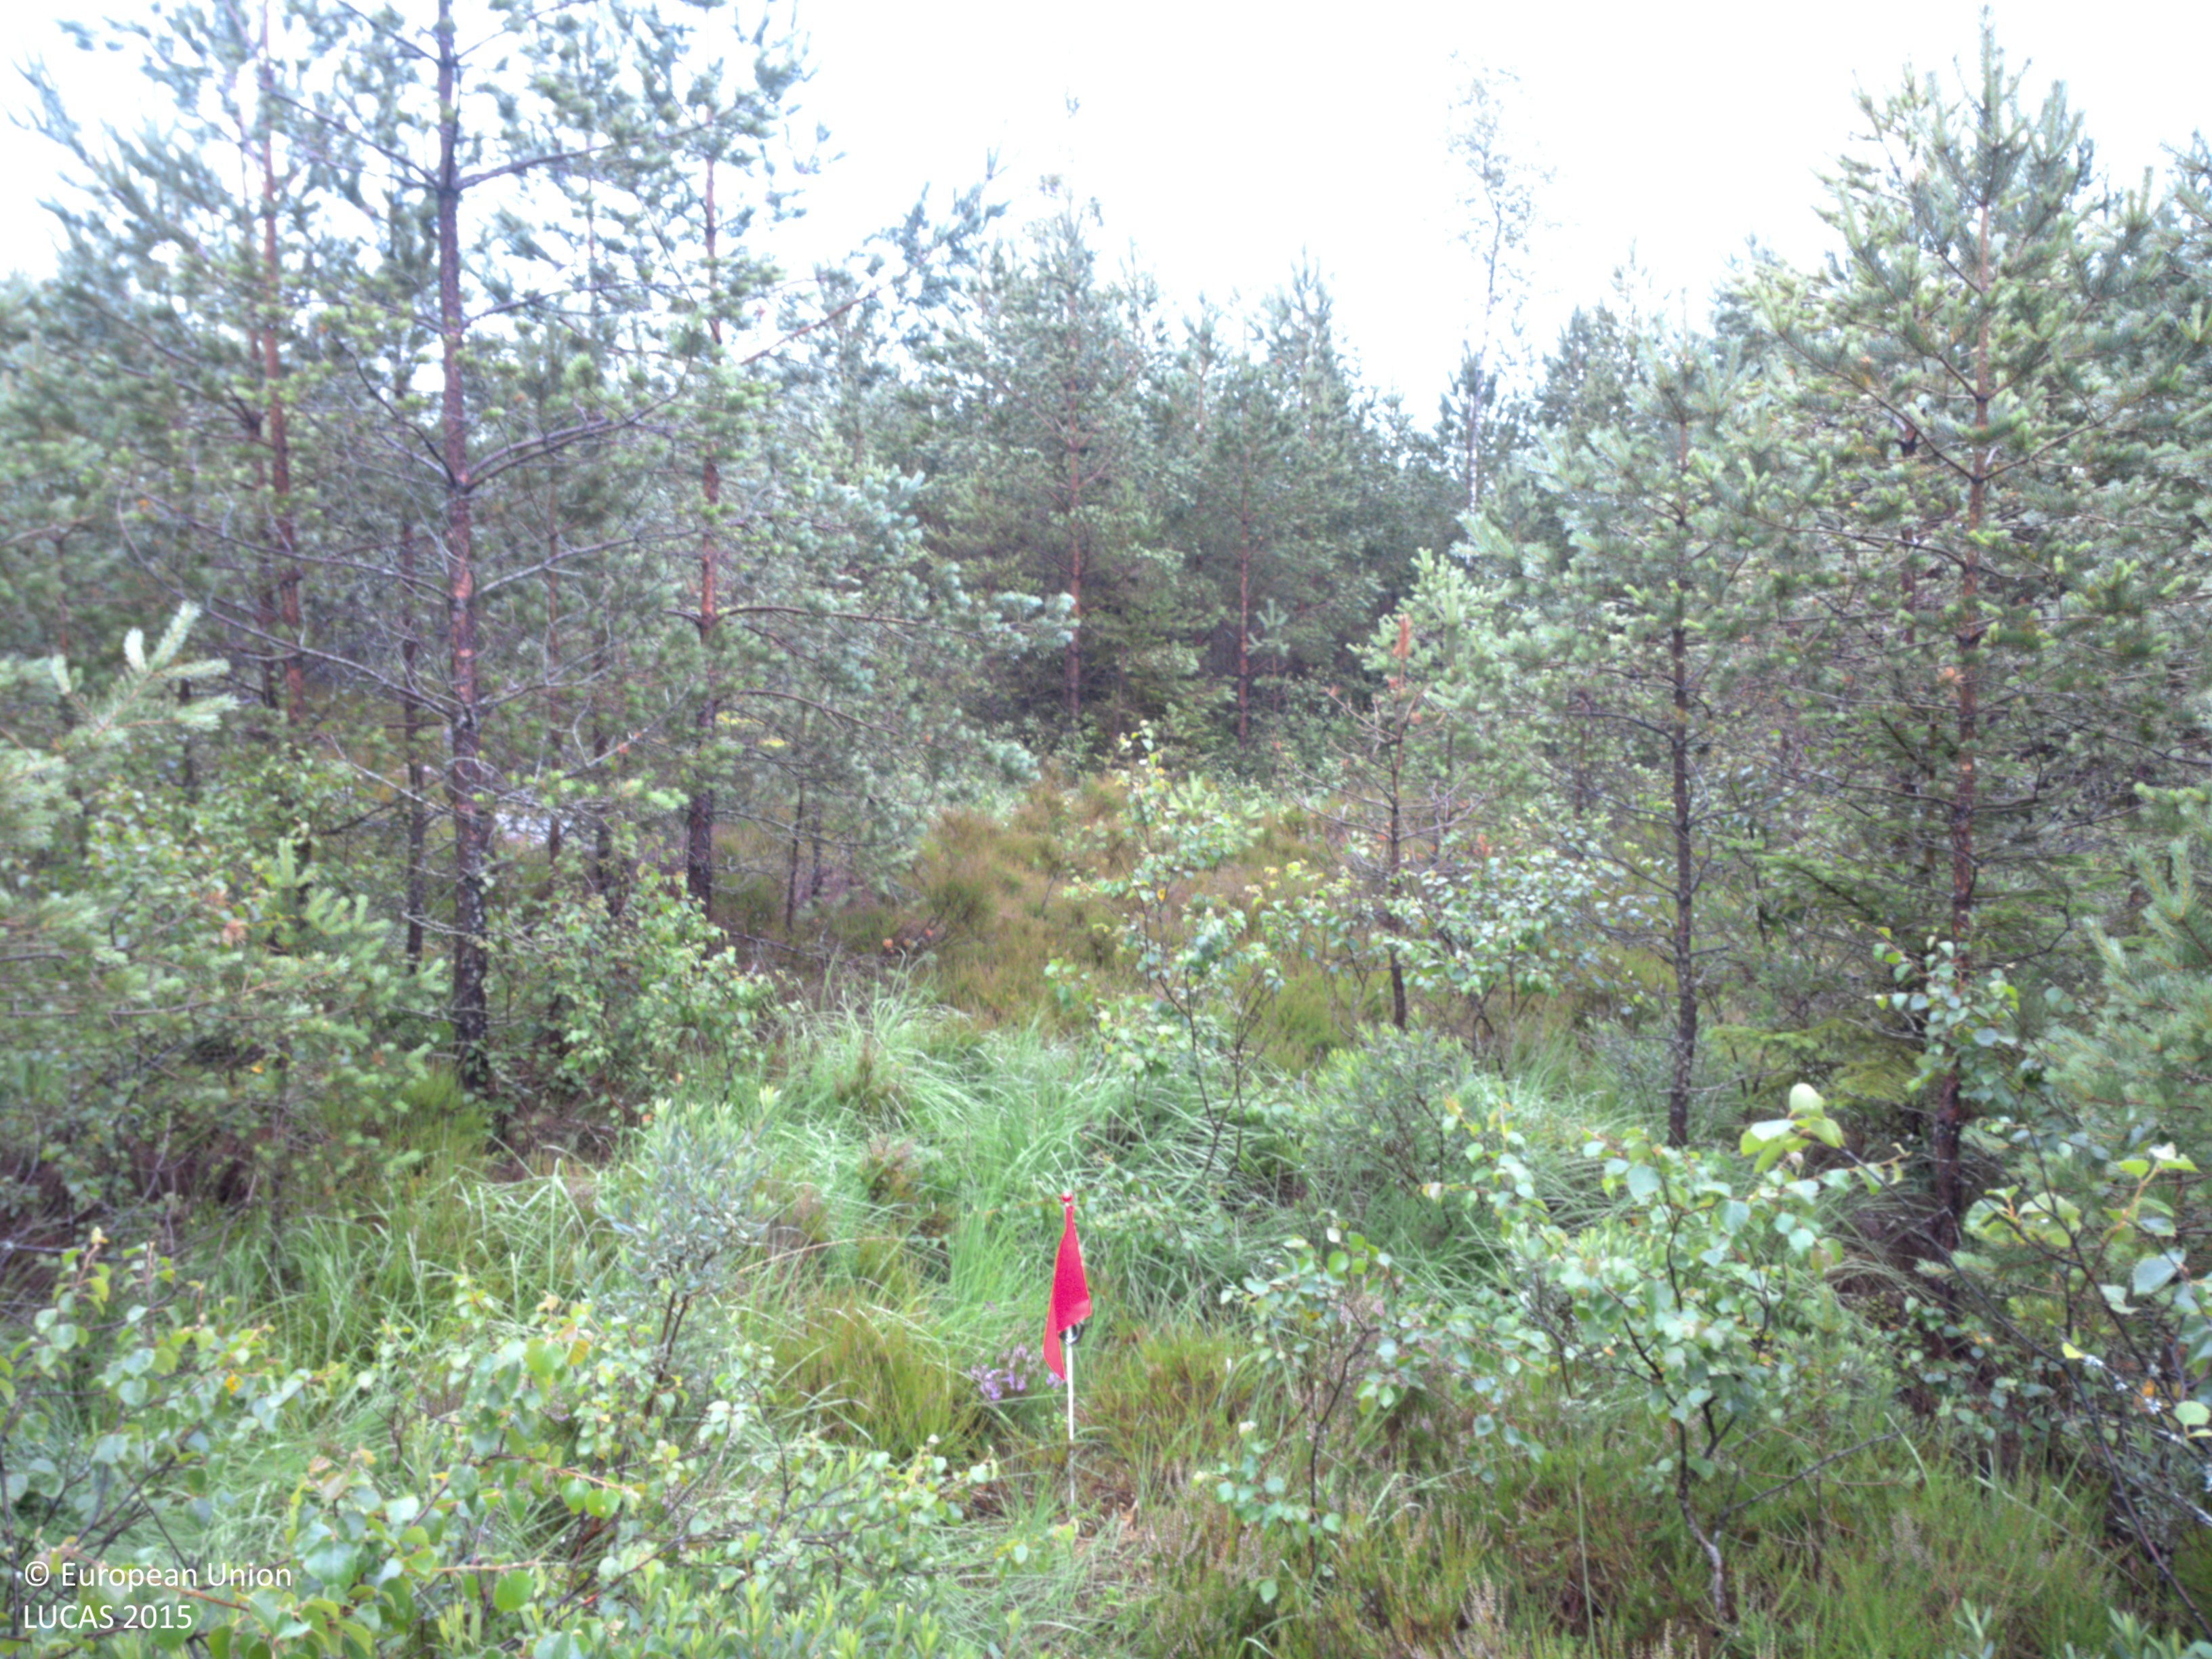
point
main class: Woodland
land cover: Pine dominated mixed woodland
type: boreal forest
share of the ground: 50 - 75 %
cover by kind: coniferous forest trees 40 %, herbaceous plants 30 %, broadleaved forest trees 15 %, shrubs 15 %
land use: Forestry
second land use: Amenities, museums, leisure
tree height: < 5 m
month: July
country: SE
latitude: 58.6944
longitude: 11.7044
